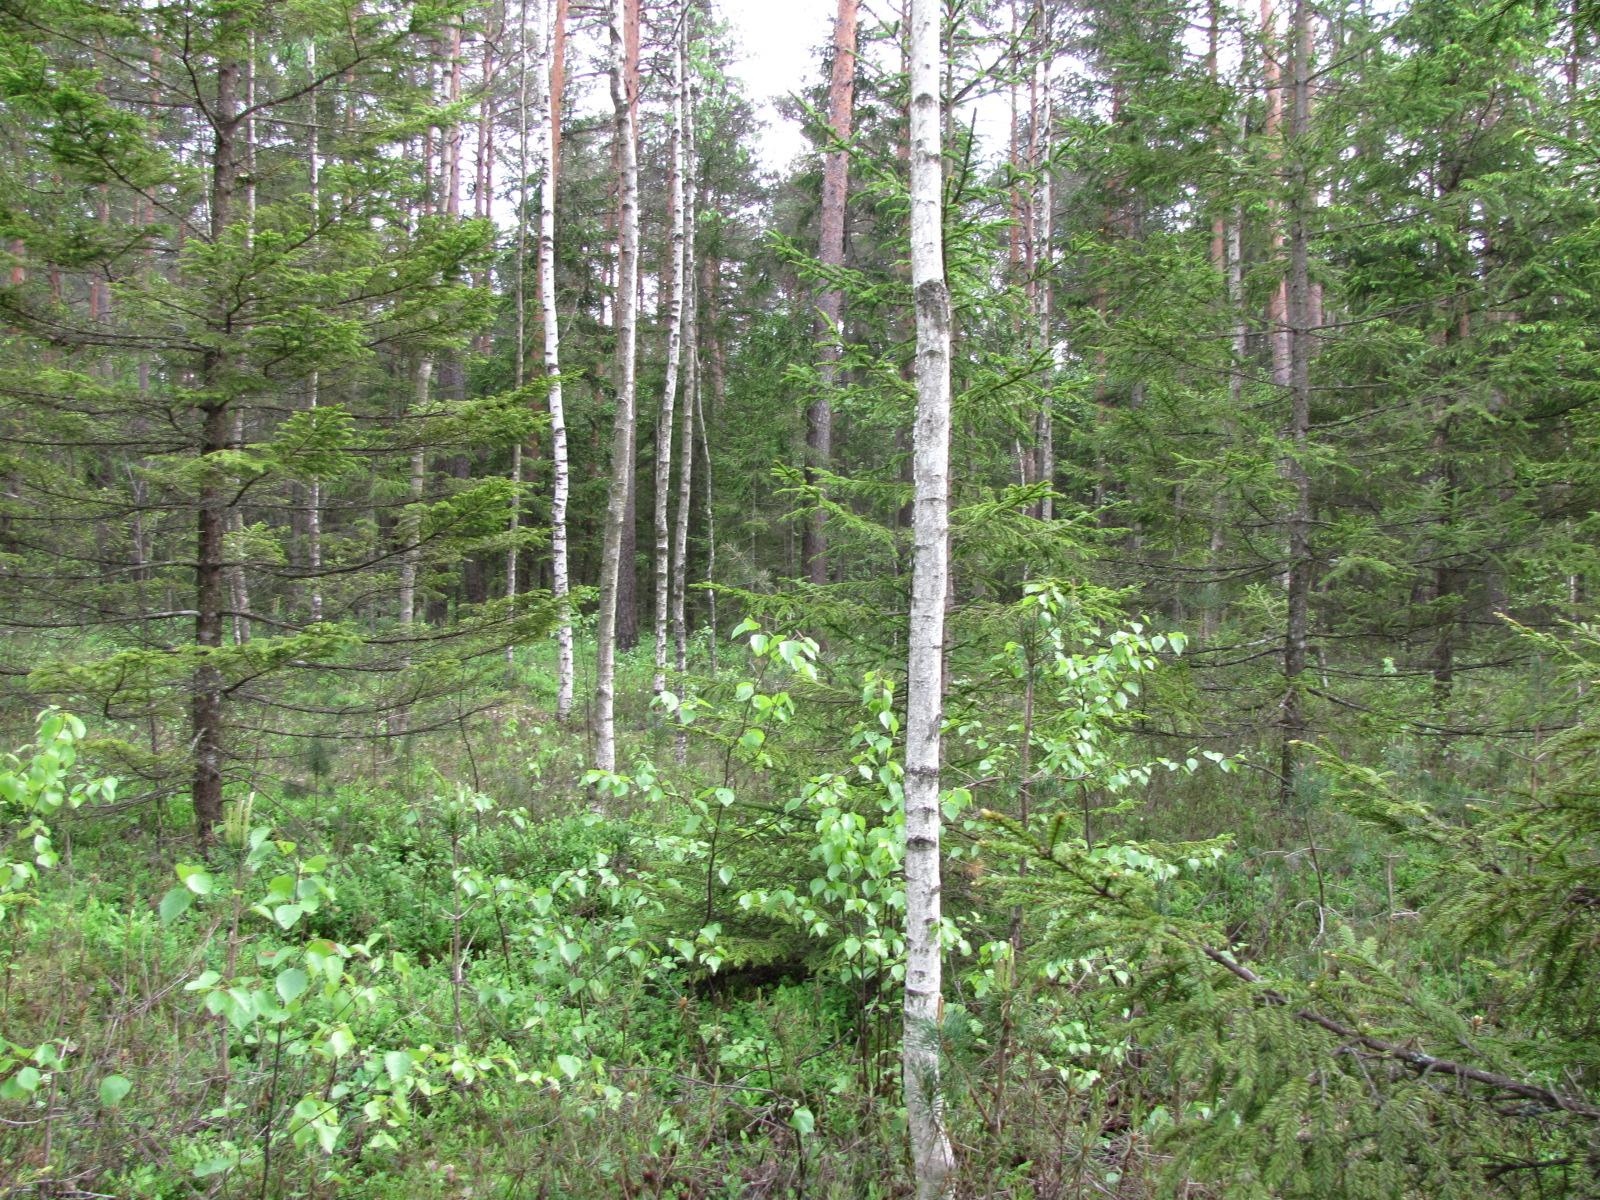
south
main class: Woodland
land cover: Spruce dominated mixed woodland
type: hemiboreal forest and nemoral coniferous forest and mixed broadleaved-coniferous forest
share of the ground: 50 - 75 %
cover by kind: coniferous forest trees 30 %, broadleaved forest trees 30 %, herbaceous plants 20 %, lichens and mosses 20 %
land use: Forestry
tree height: > 5 m
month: June
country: LV
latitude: 56.6442
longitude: 24.2944
